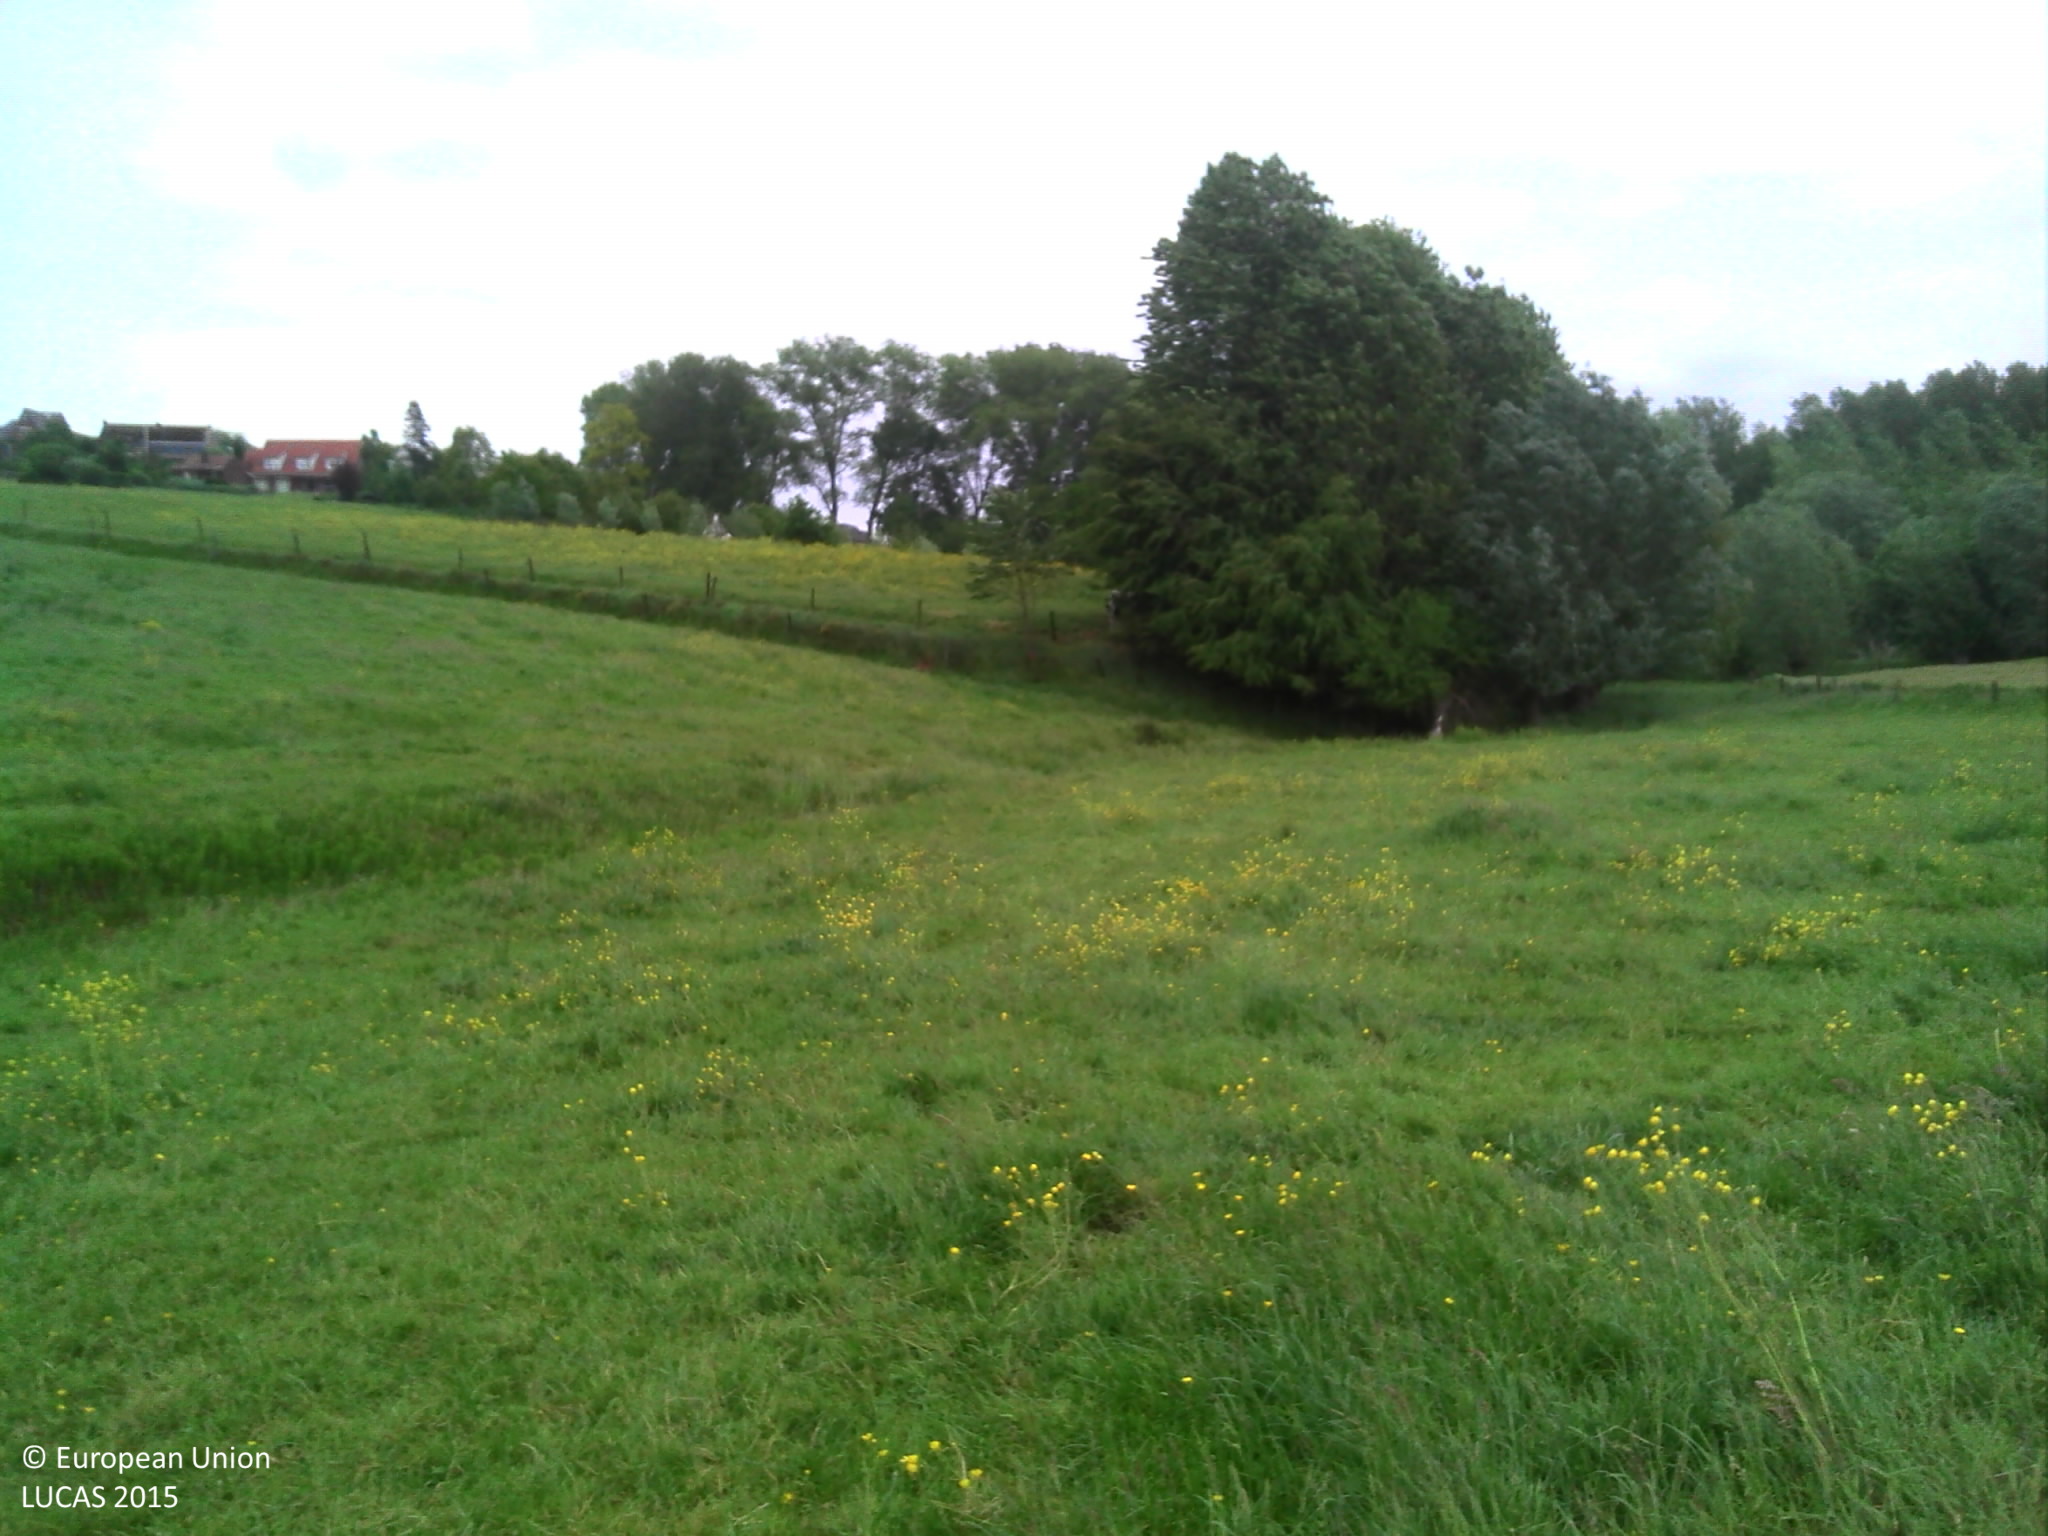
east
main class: Grassland
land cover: Grassland without tree/shrub cover
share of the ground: > 75 %
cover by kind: herbaceous plants 100 %
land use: Agriculture (excluding fallow land and kitchen gardens)
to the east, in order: Grassland without tree/shrub cover; Rivers and streams; Grassland without tree/shrub cover; Fences; Broadleaved woodland; Fences; Grassland without tree/shrub cover; Ditches and canals; Fences; Broadleaved woodland; Grassland with sparse tree/shrub cover; Rivers and streams; Grassland with sparse tree/shrub cover; Ditches and canals; Grassland with sparse tree/shrub cover; Tracks; Broadleaved woodland
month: June
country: BE
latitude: 50.8265
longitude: 3.7894
